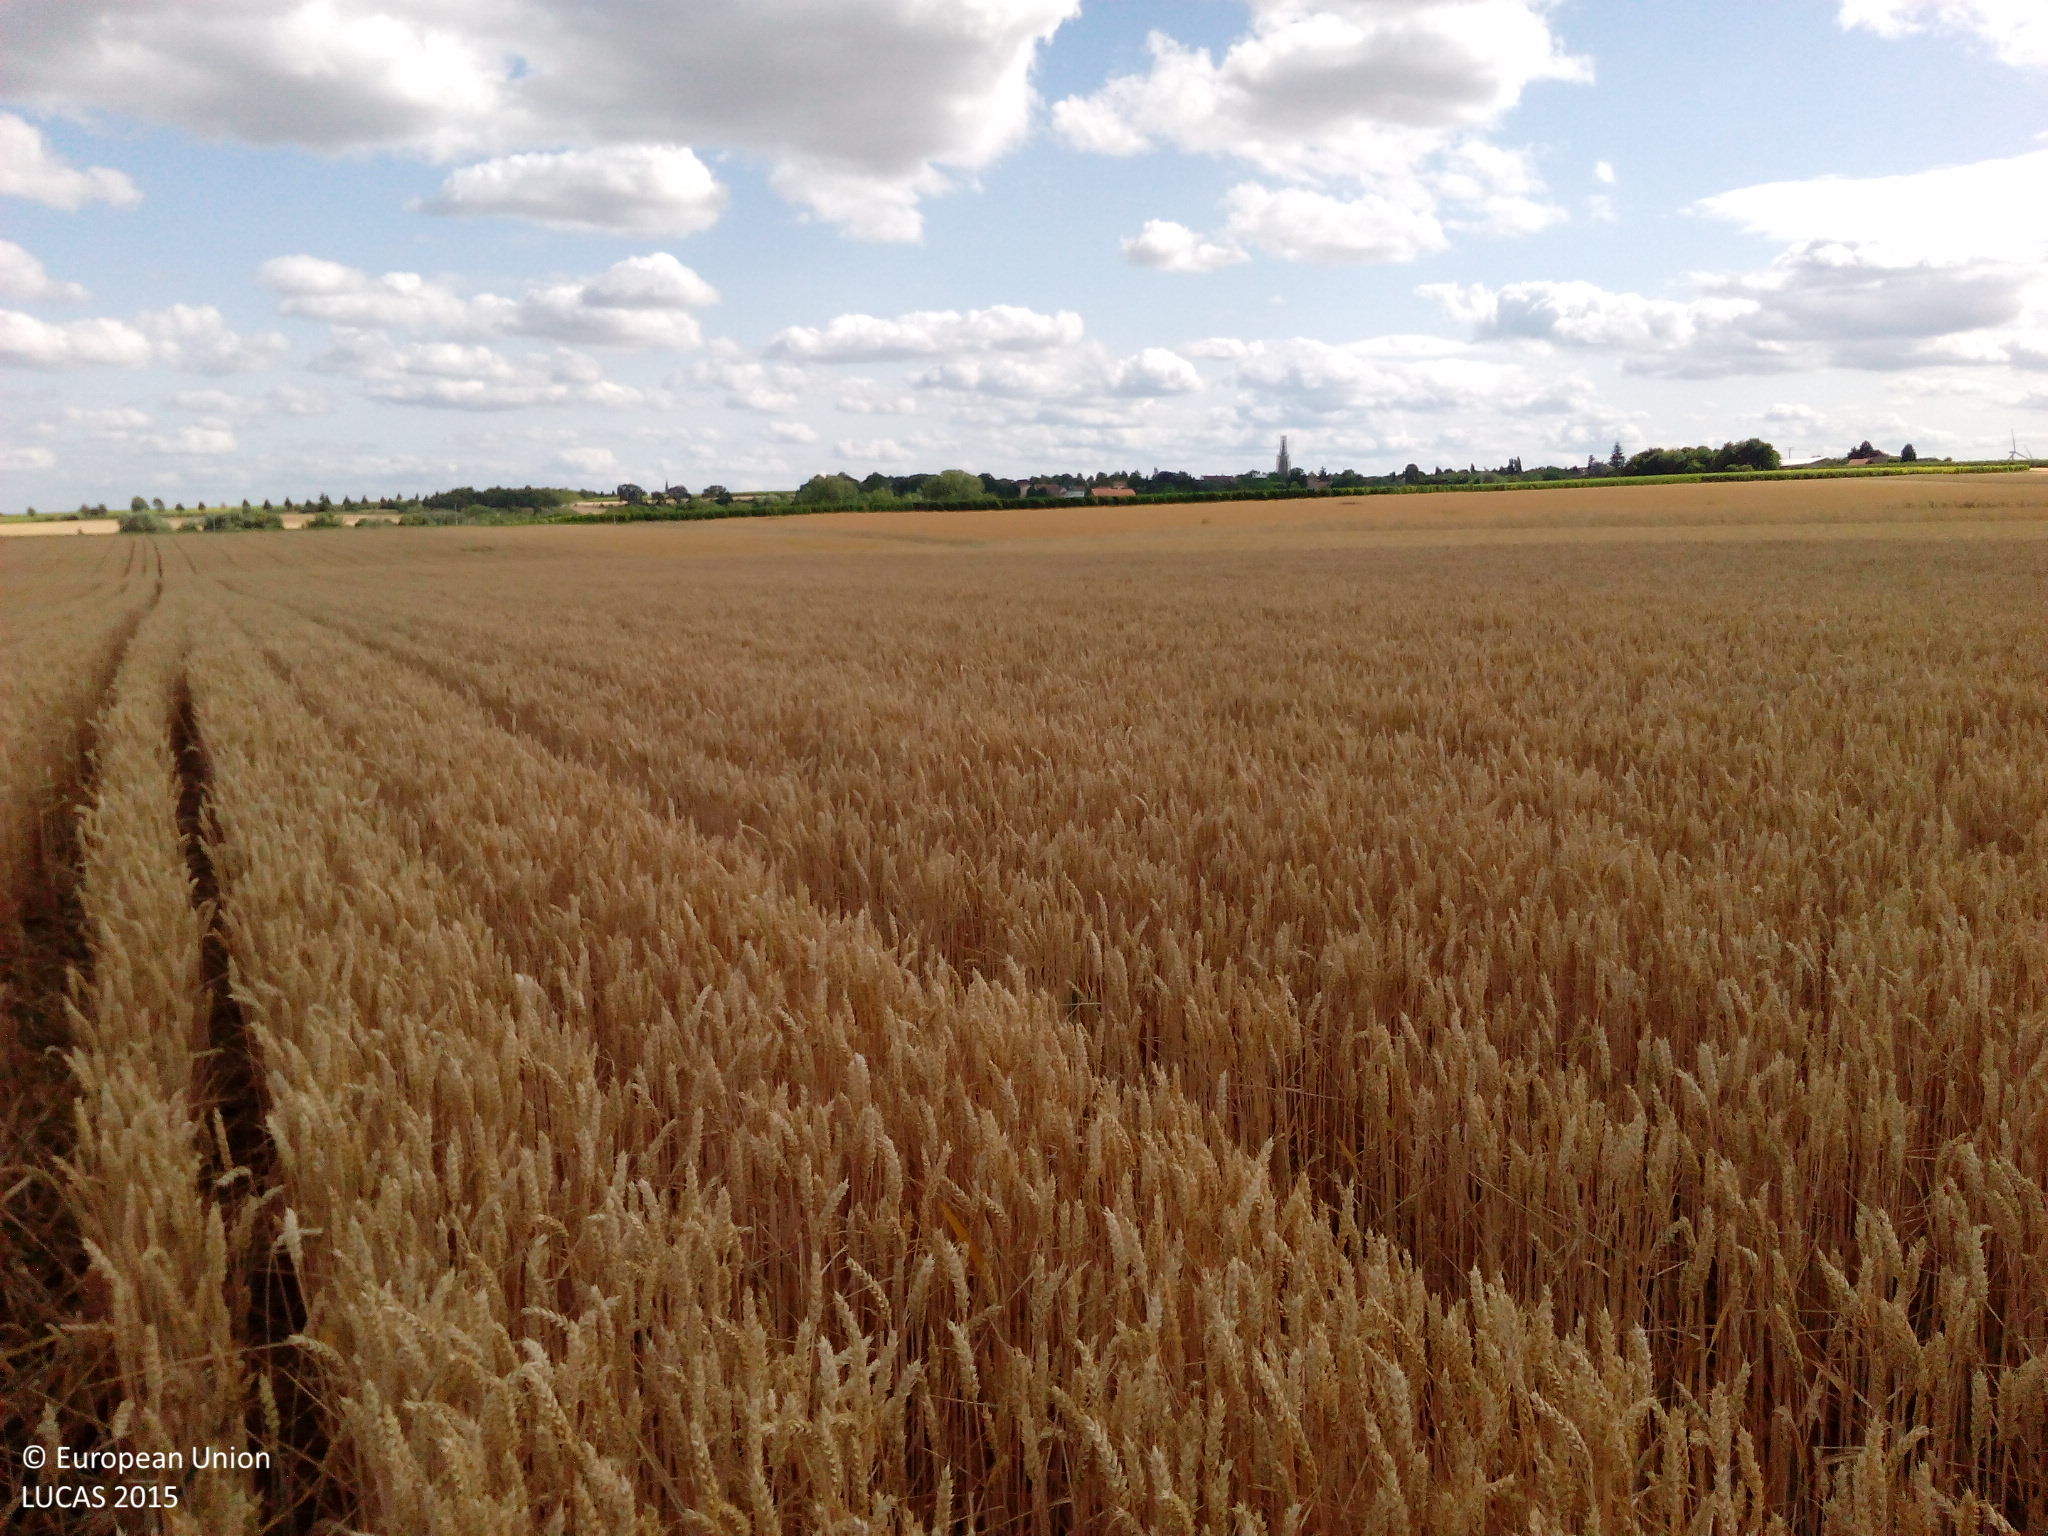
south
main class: Cropland
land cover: Common wheat
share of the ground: > 75 %
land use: Agriculture (excluding fallow land and kitchen gardens)
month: July
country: DE
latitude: 49.7017
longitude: 8.1564
